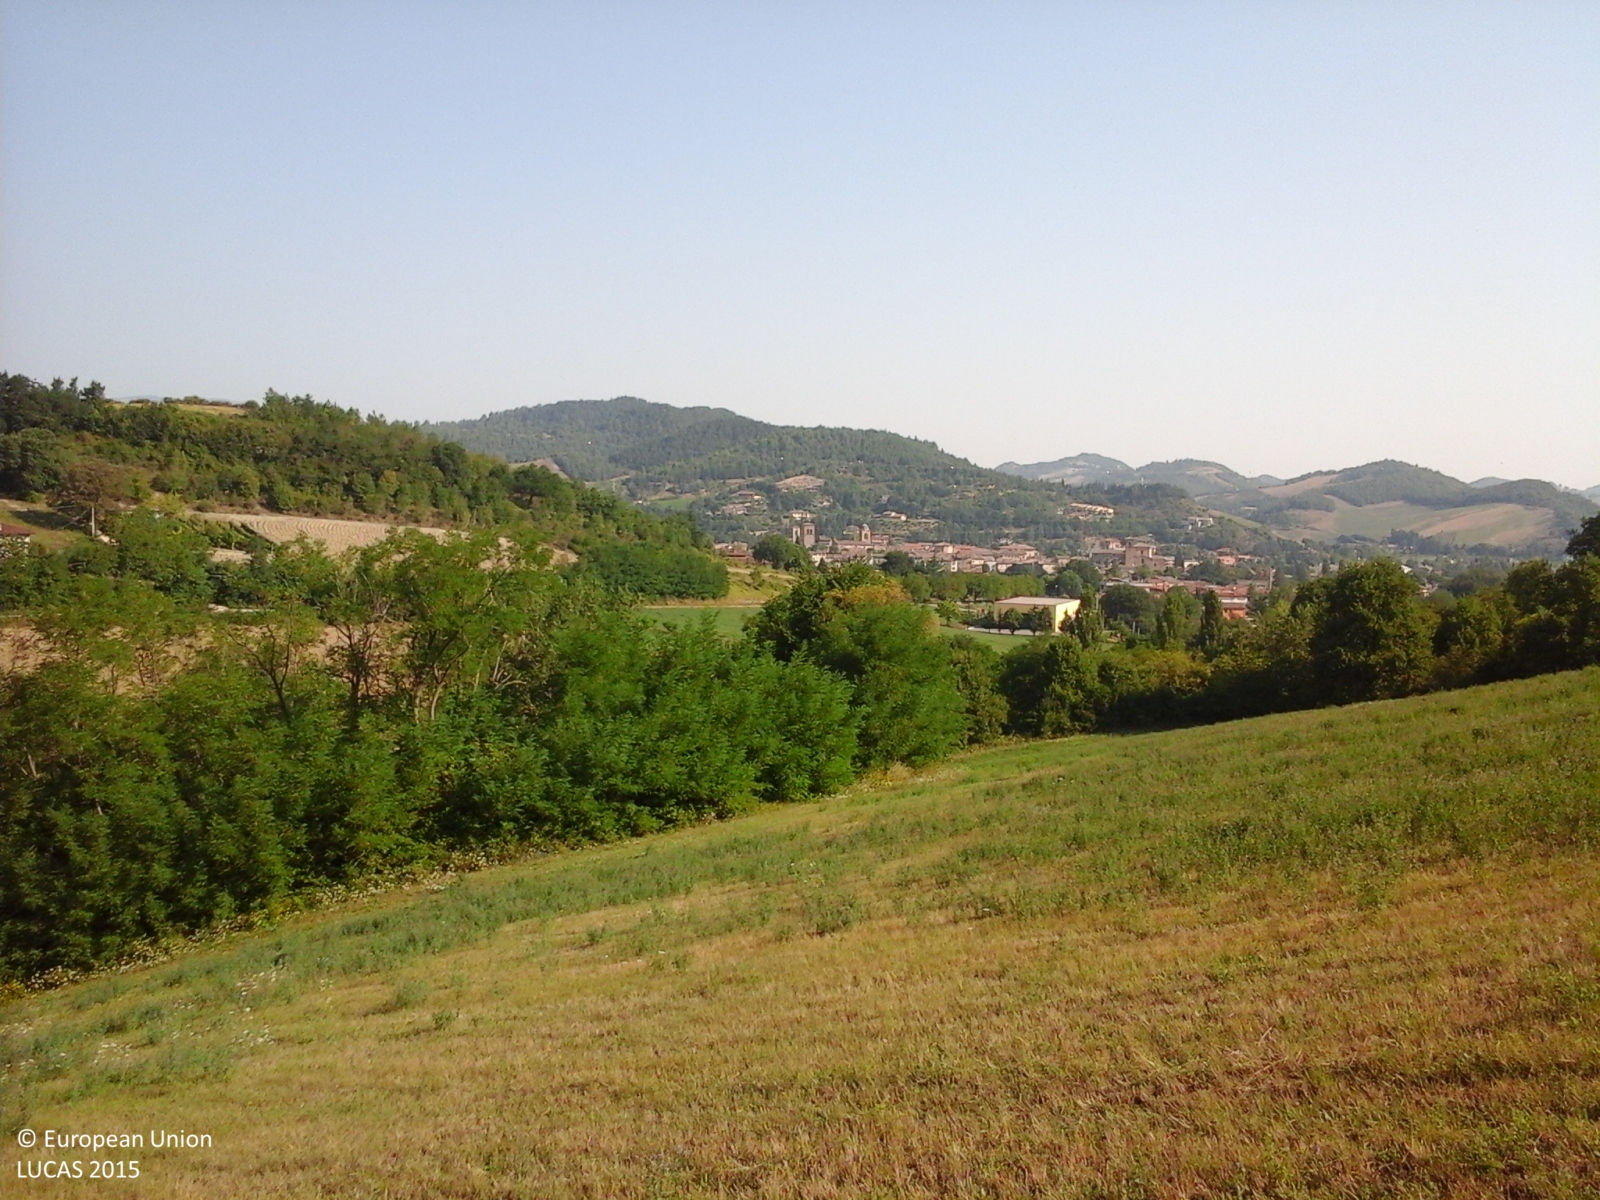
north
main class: Cropland
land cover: Lucerne
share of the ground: > 75 %
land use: Agriculture (excluding fallow land and kitchen gardens)
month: August
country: IT
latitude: 43.6548
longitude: 12.4117
